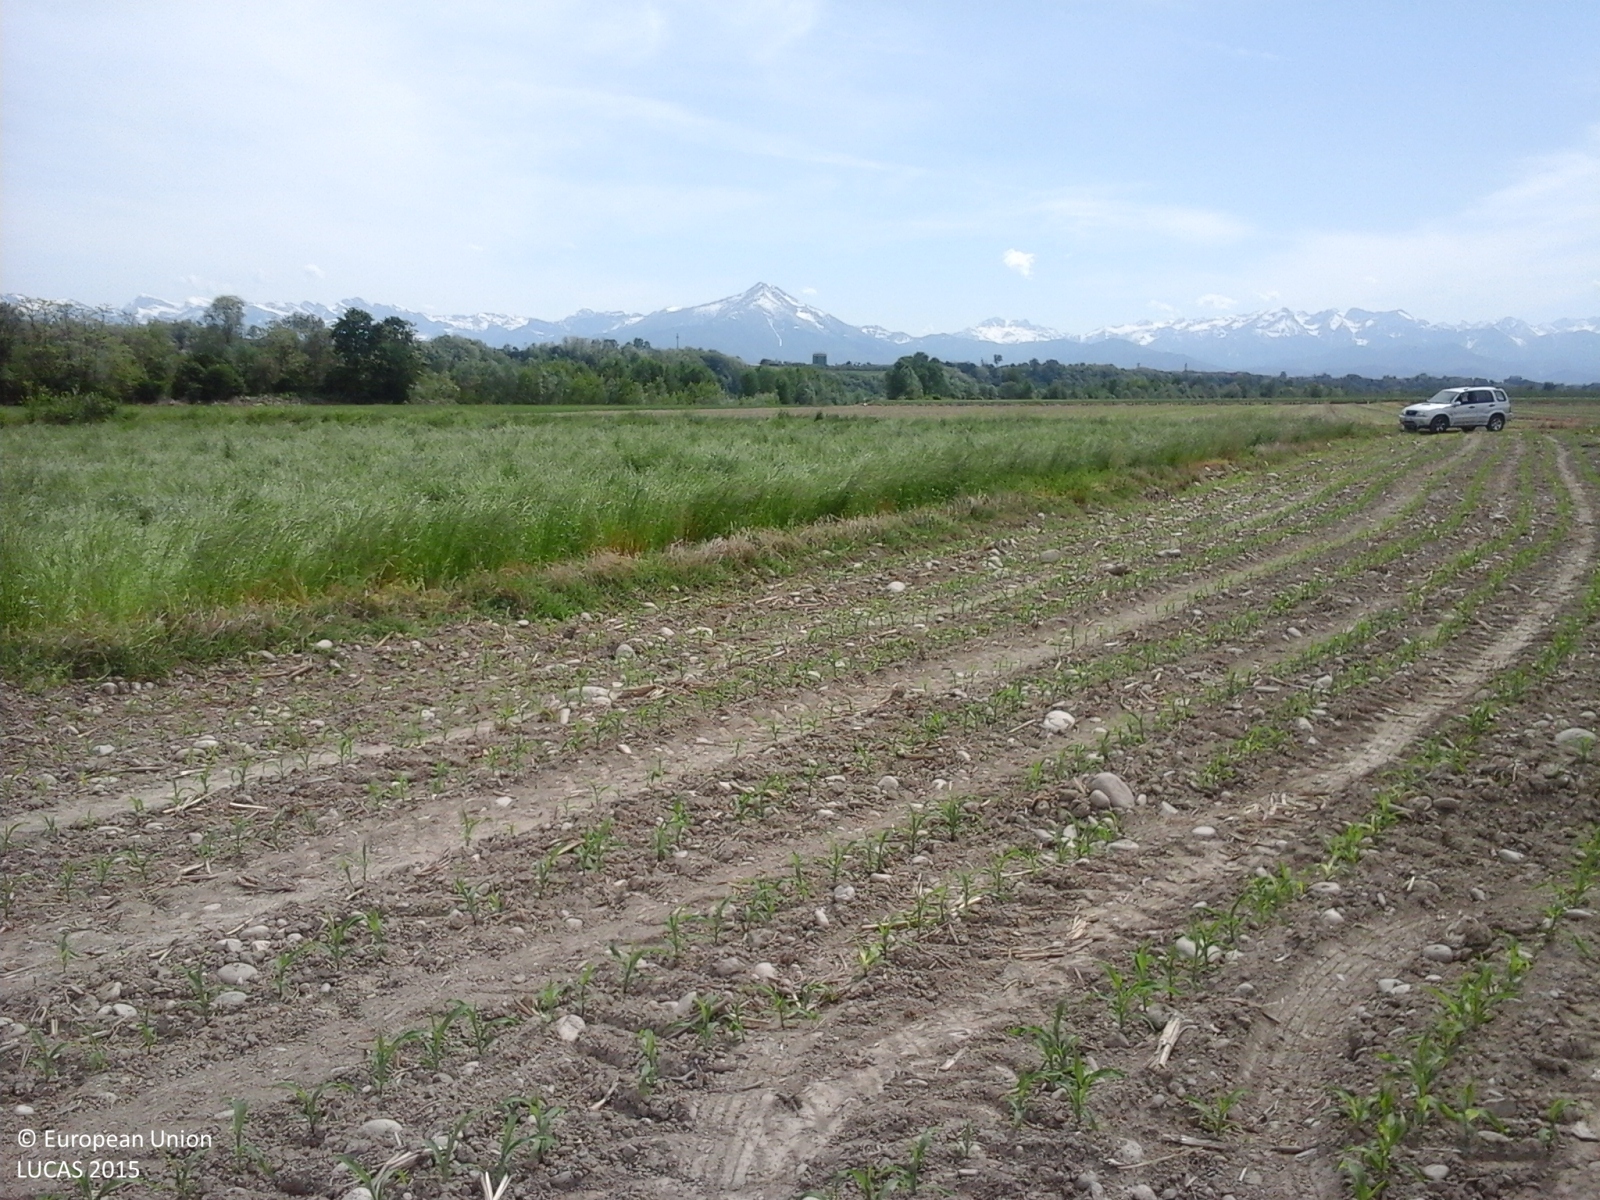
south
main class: Cropland
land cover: Maize
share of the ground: 25 - 50 %
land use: Agriculture (excluding fallow land and kitchen gardens)
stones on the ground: 25 - 50 %
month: May
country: IT
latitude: 44.4684
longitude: 7.6542
